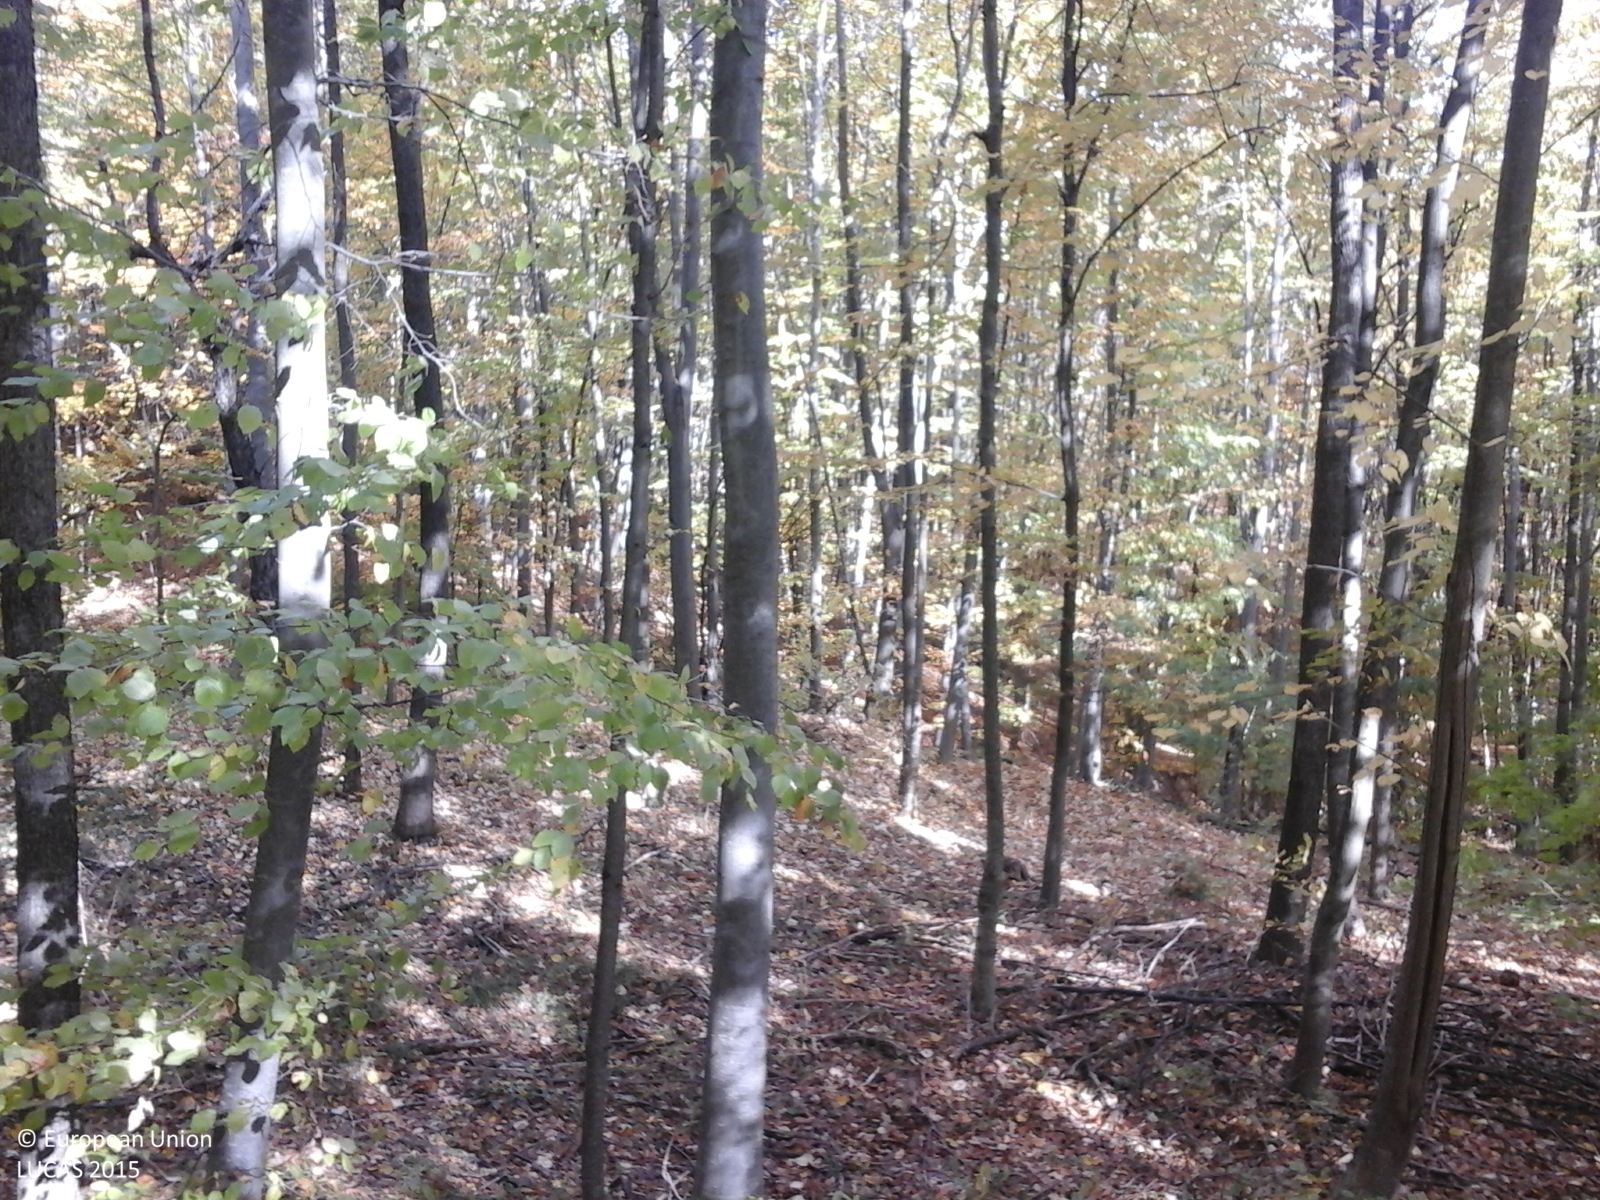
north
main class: Woodland
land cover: Broadleaved woodland
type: beech forest
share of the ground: > 75 %
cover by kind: broadleaved forest trees 100 %
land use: Forestry
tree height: > 5 m
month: October
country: RO
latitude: 45.1691
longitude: 26.4973
